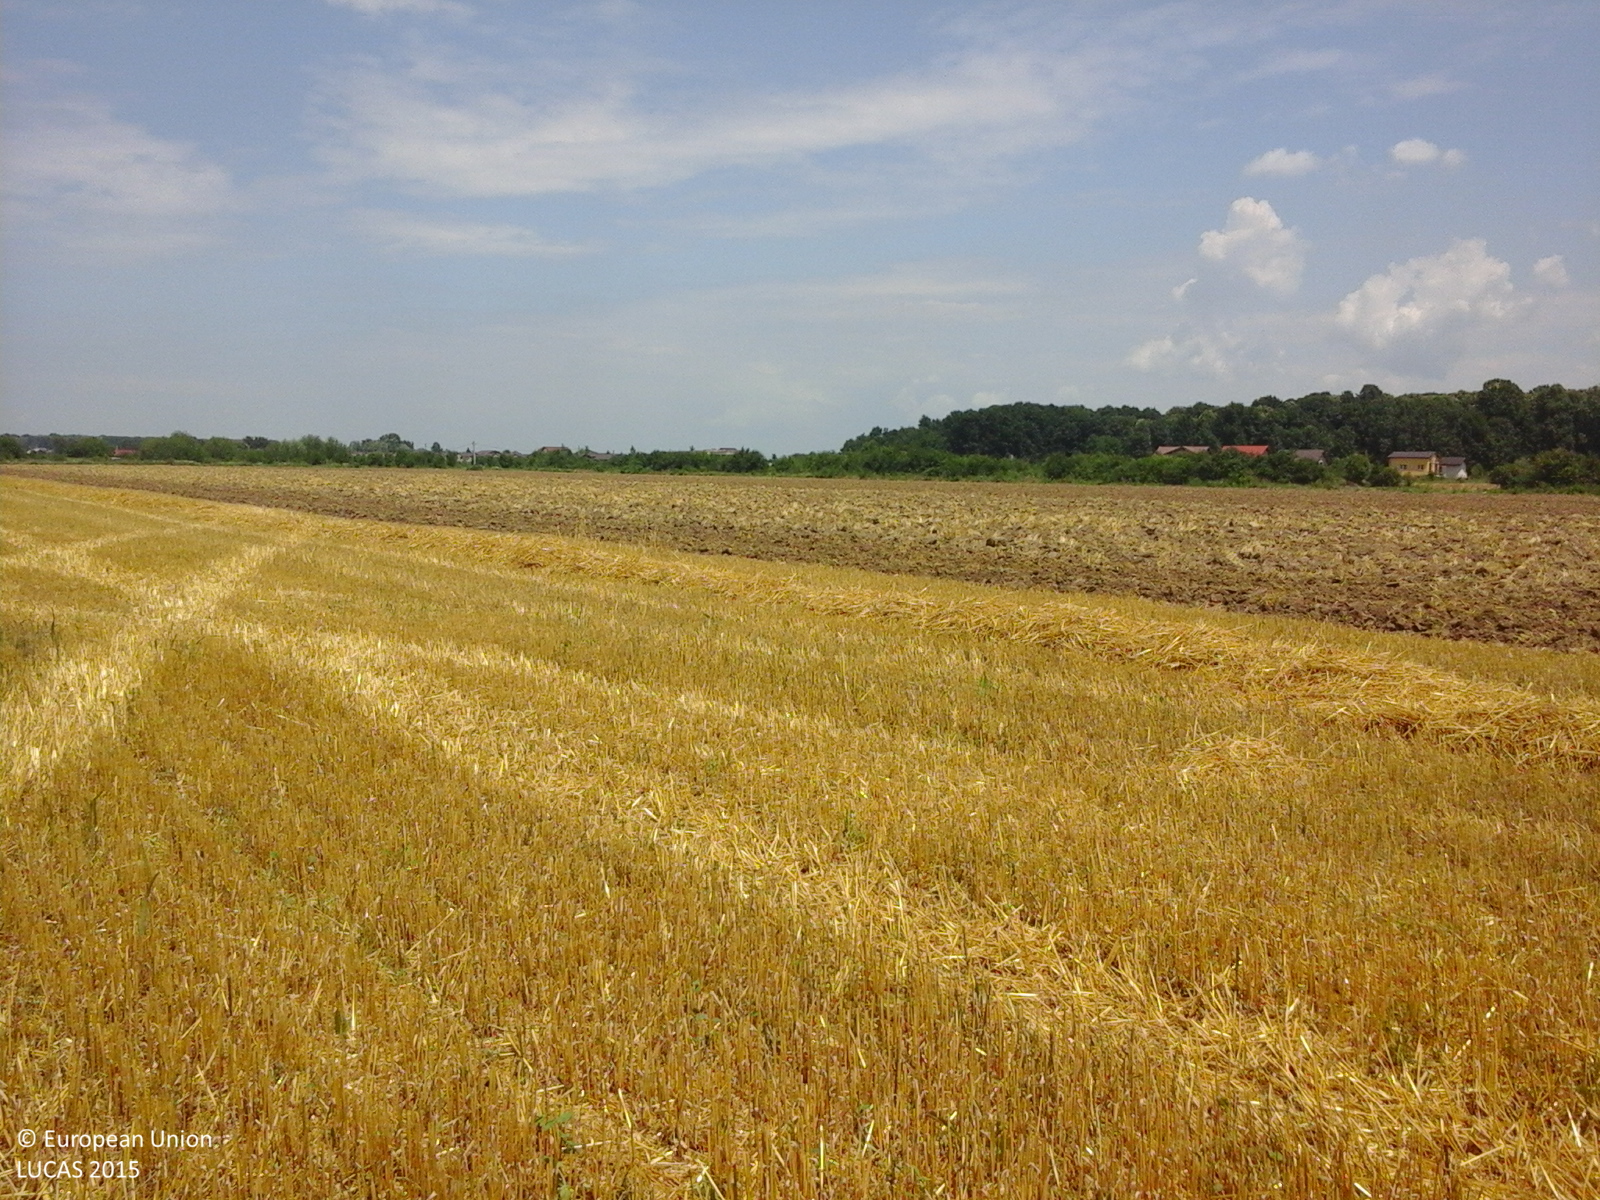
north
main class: Cropland
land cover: Barley
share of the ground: > 75 %
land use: Agriculture (excluding fallow land and kitchen gardens)
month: June
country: RO
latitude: 44.3675
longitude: 25.8726
